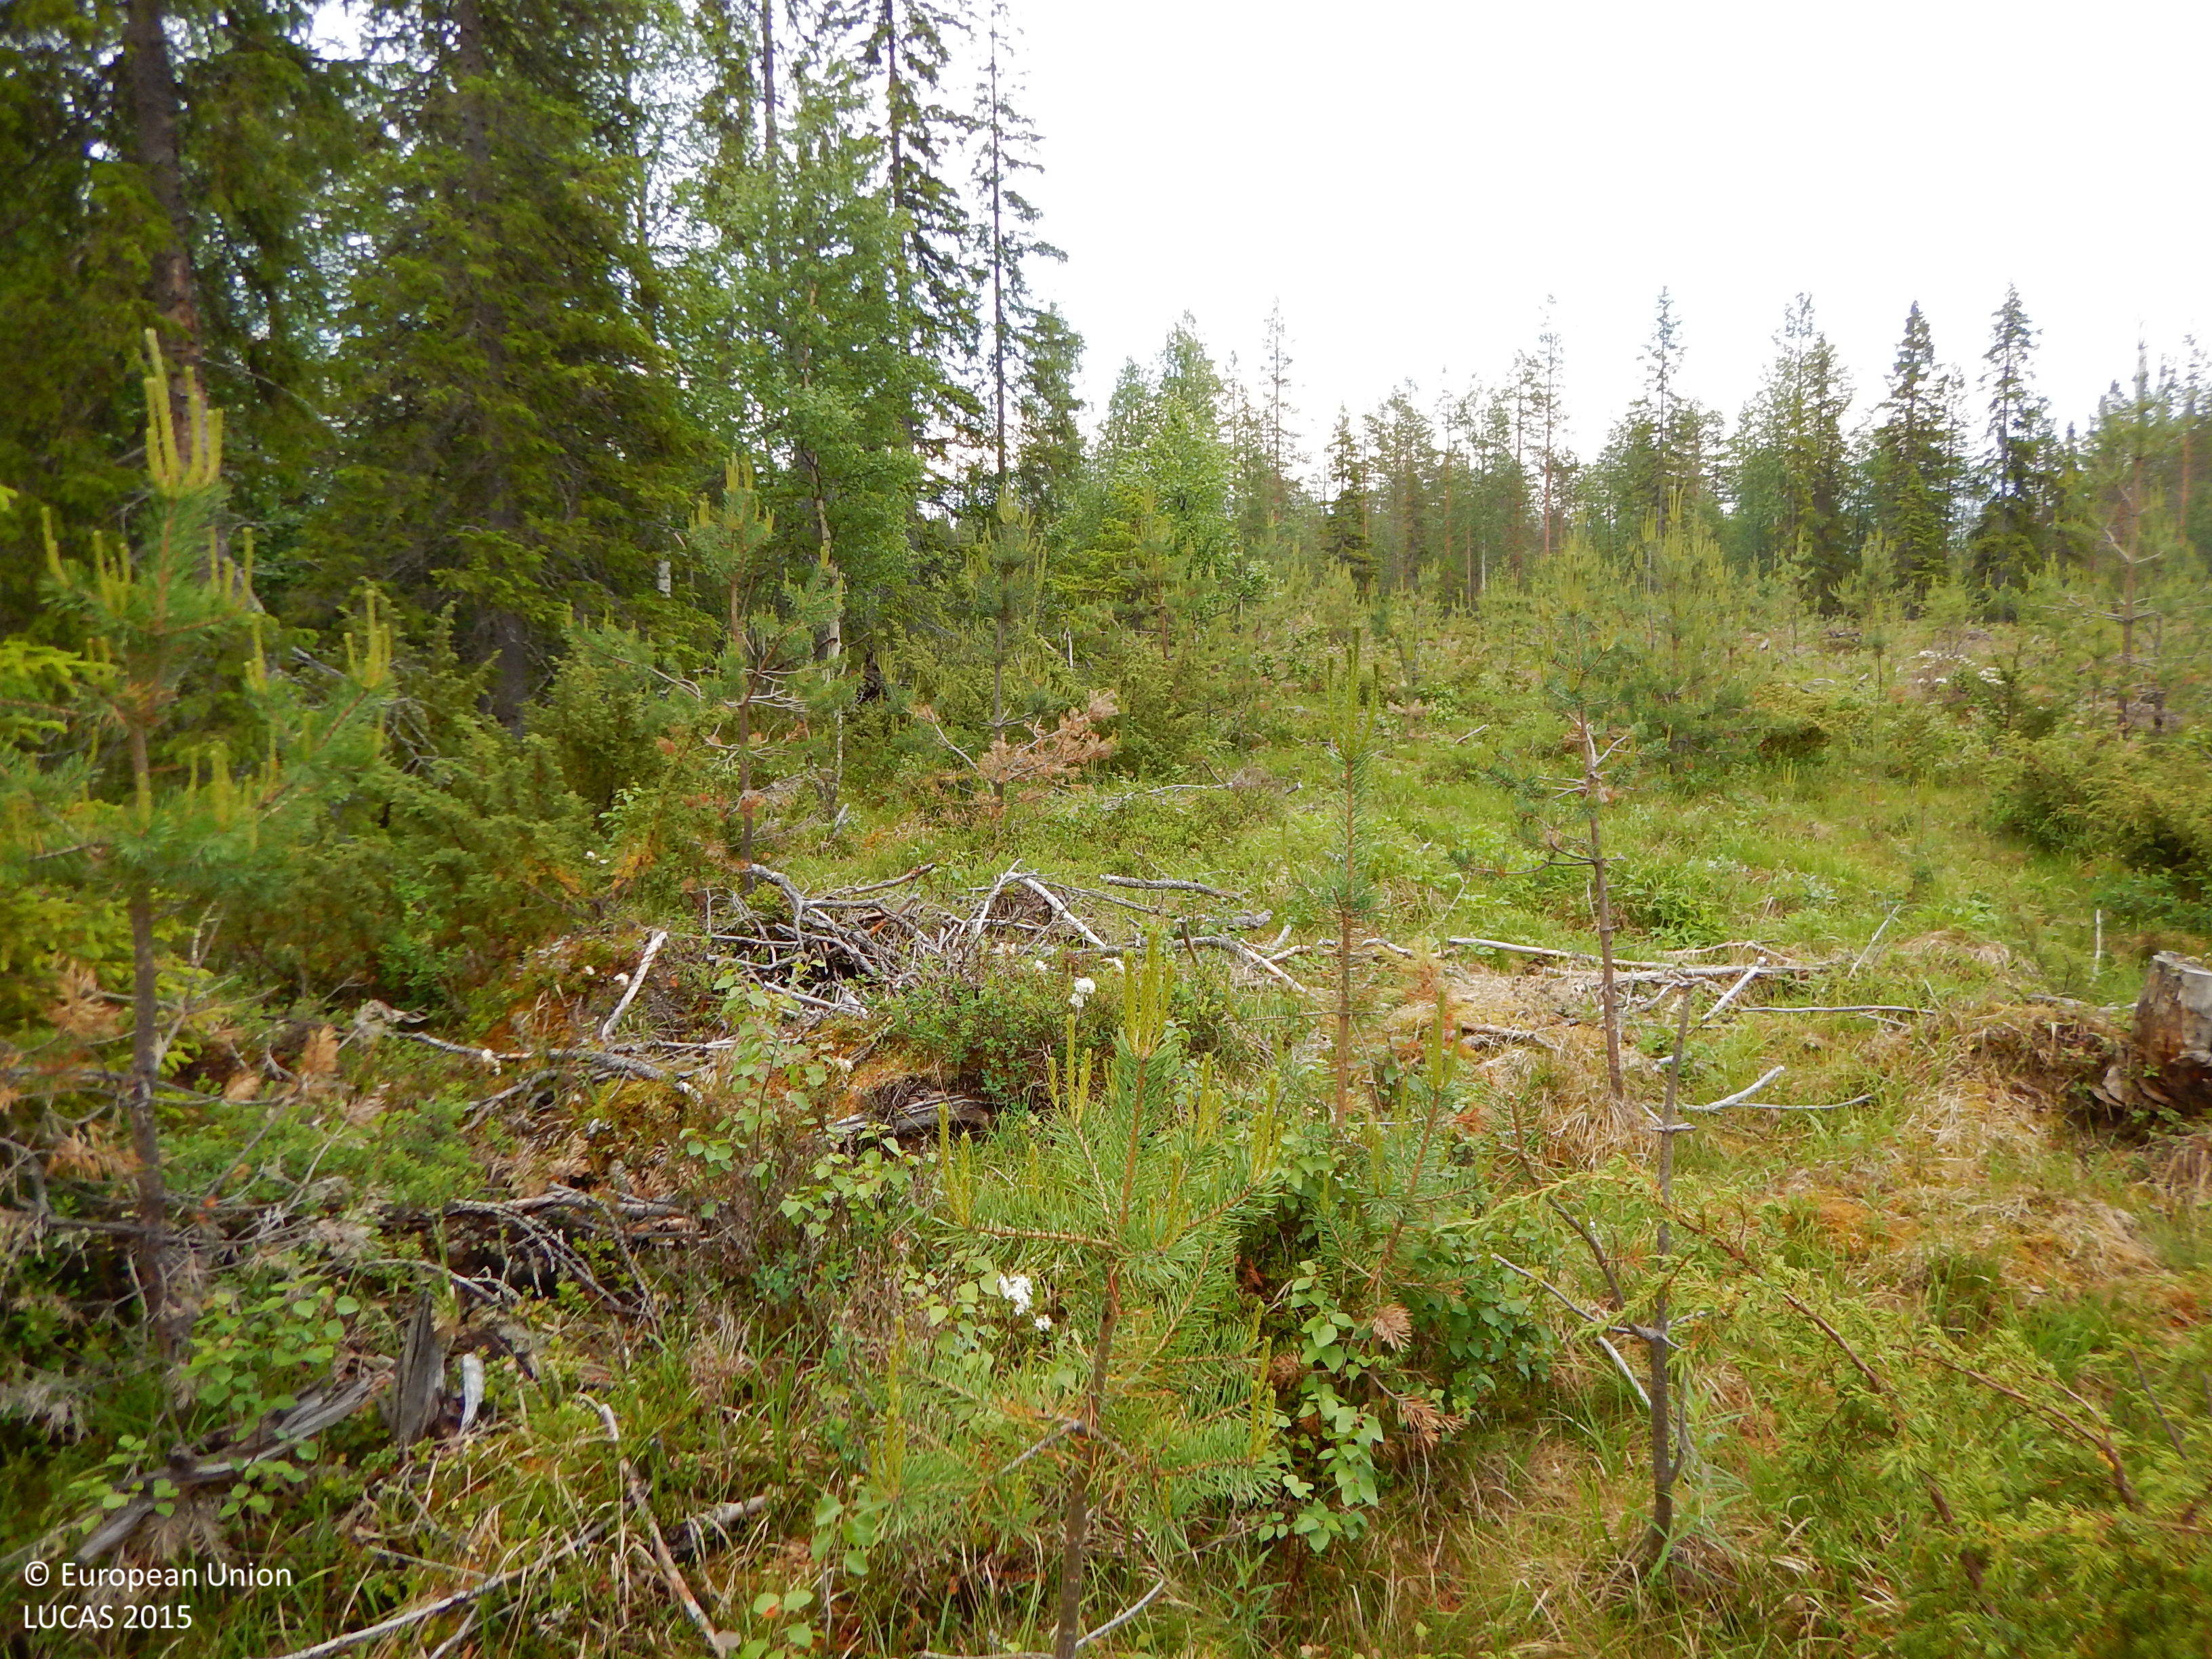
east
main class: Woodland
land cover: Pine dominated coniferous woodland
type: boreal forest
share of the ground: 10 - 25 %
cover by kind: herbaceous plants 45 %, coniferous forest trees 15 %, consolidated bare surface 15 %, shrubs 10 %, lichens and mosses 10 %, broadleaved forest trees 5 %
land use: Forestry
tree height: < 5 m
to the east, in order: Pine dominated coniferous woodland
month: July
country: SE
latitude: 65.2554
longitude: 19.2778
